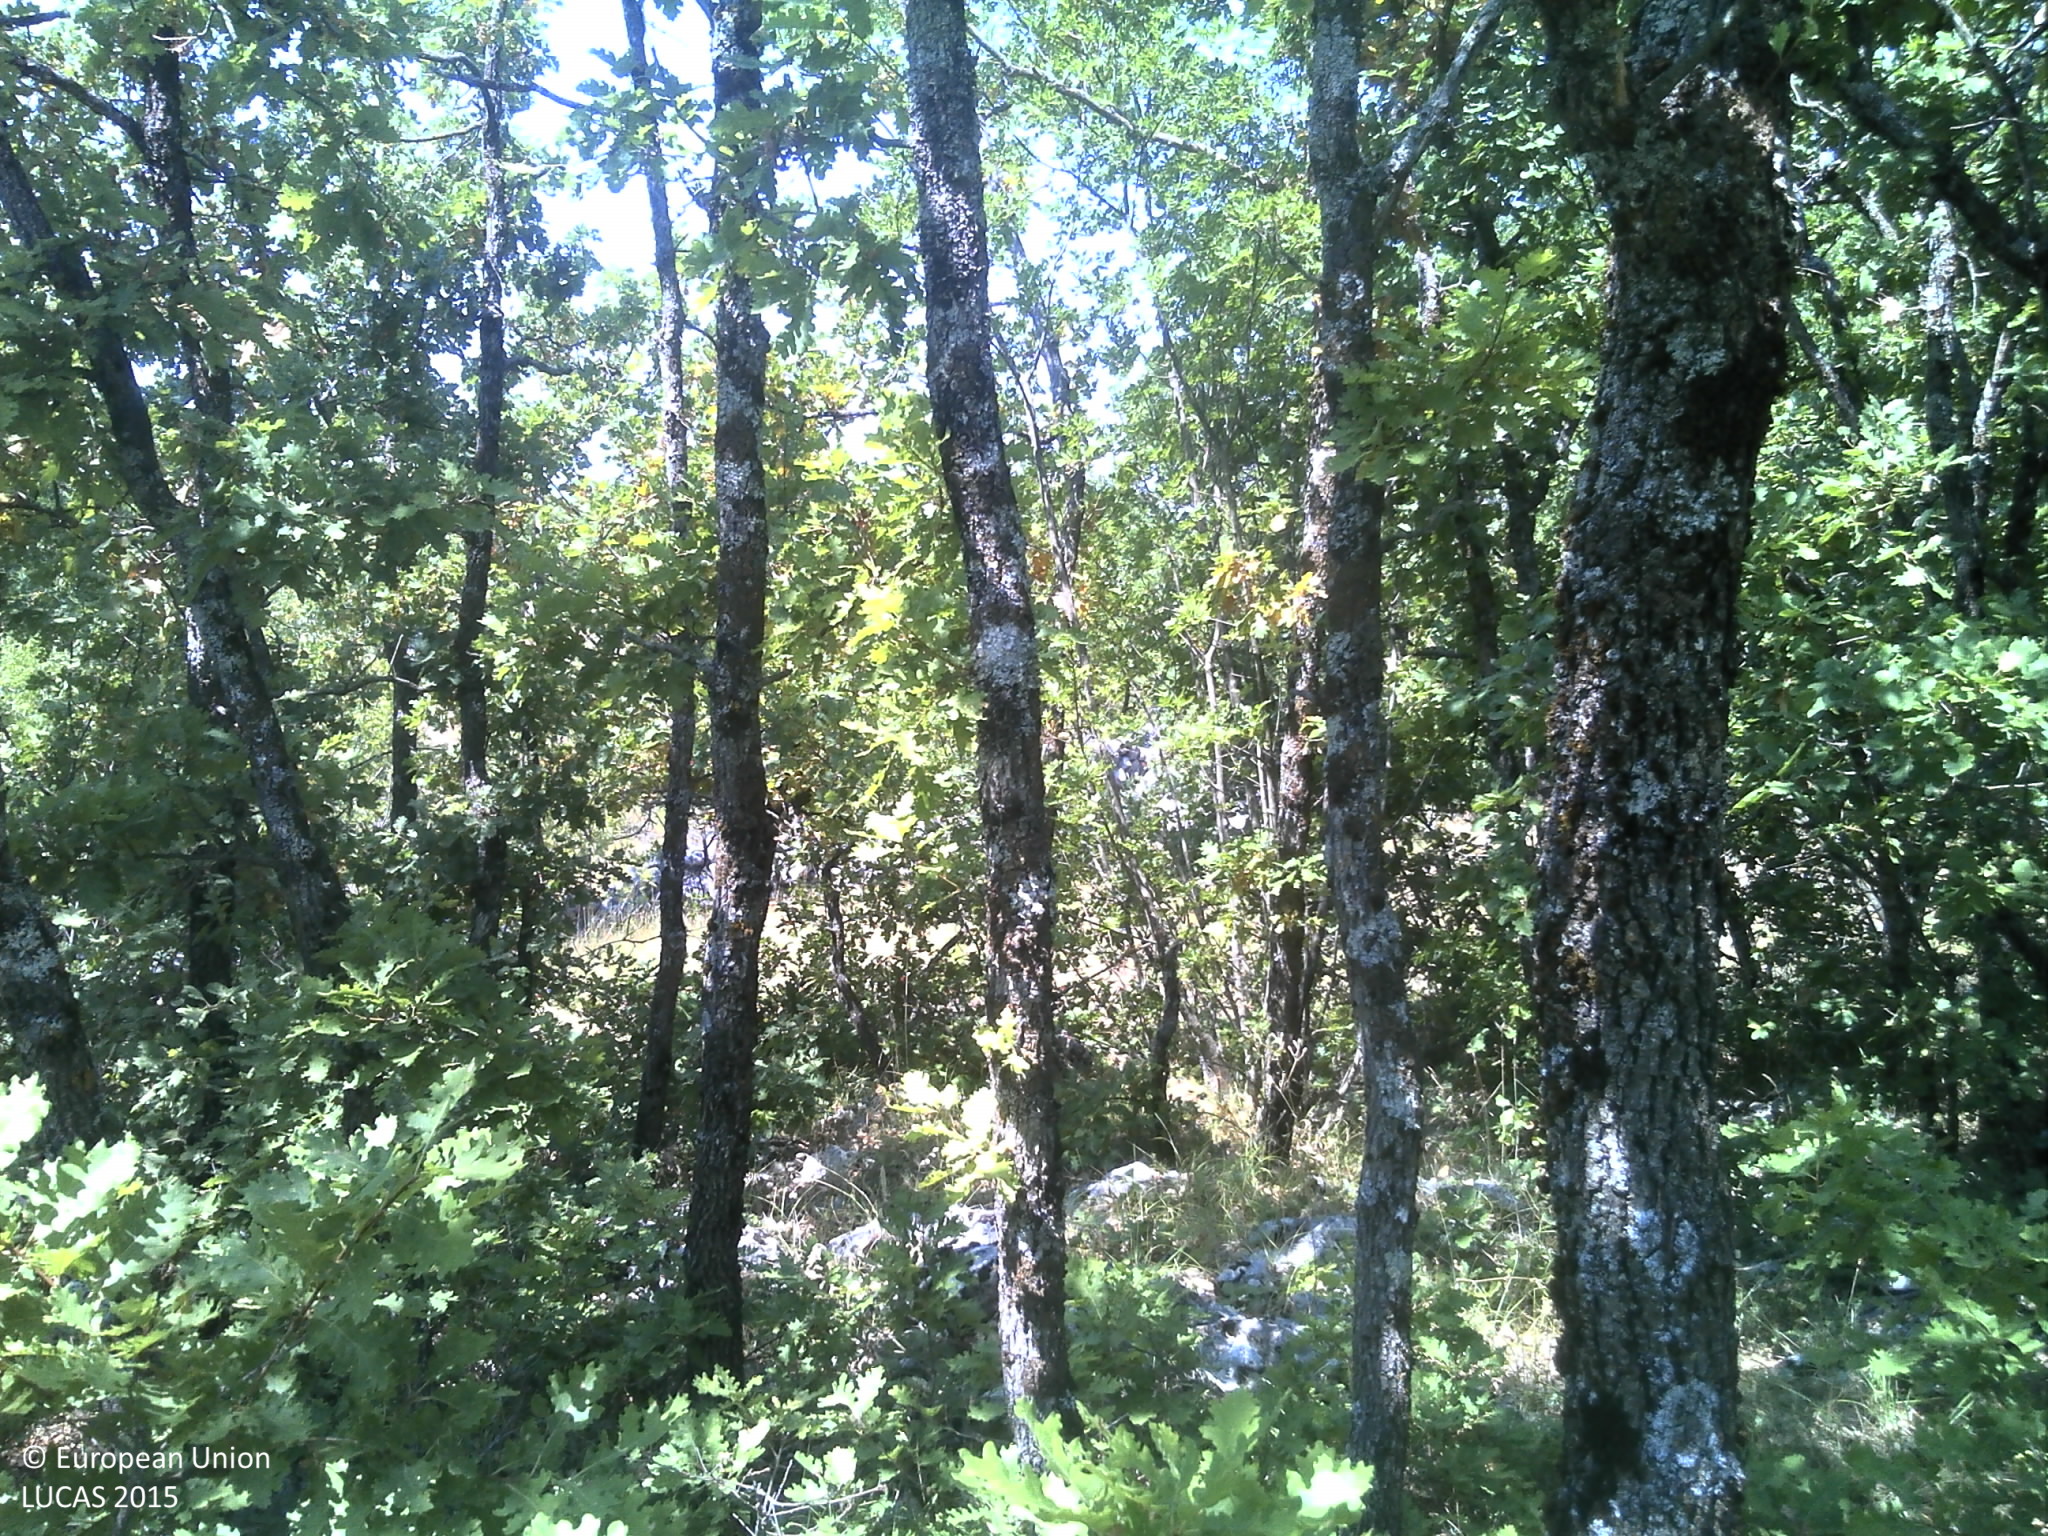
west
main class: Woodland
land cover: Broadleaved woodland
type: thermophilous deciduous forest
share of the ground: > 75 %
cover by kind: broadleaved forest trees 70 %, shrubs 10 %, herbaceous plants 5 %, lichens and mosses 5 %, consolidated bare surface 5 %, unconsolidated bare surface 5 %
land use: Semi-natural and natural areas not in use
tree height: > 5 m
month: July
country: HR
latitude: 43.4632
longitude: 17.2474
